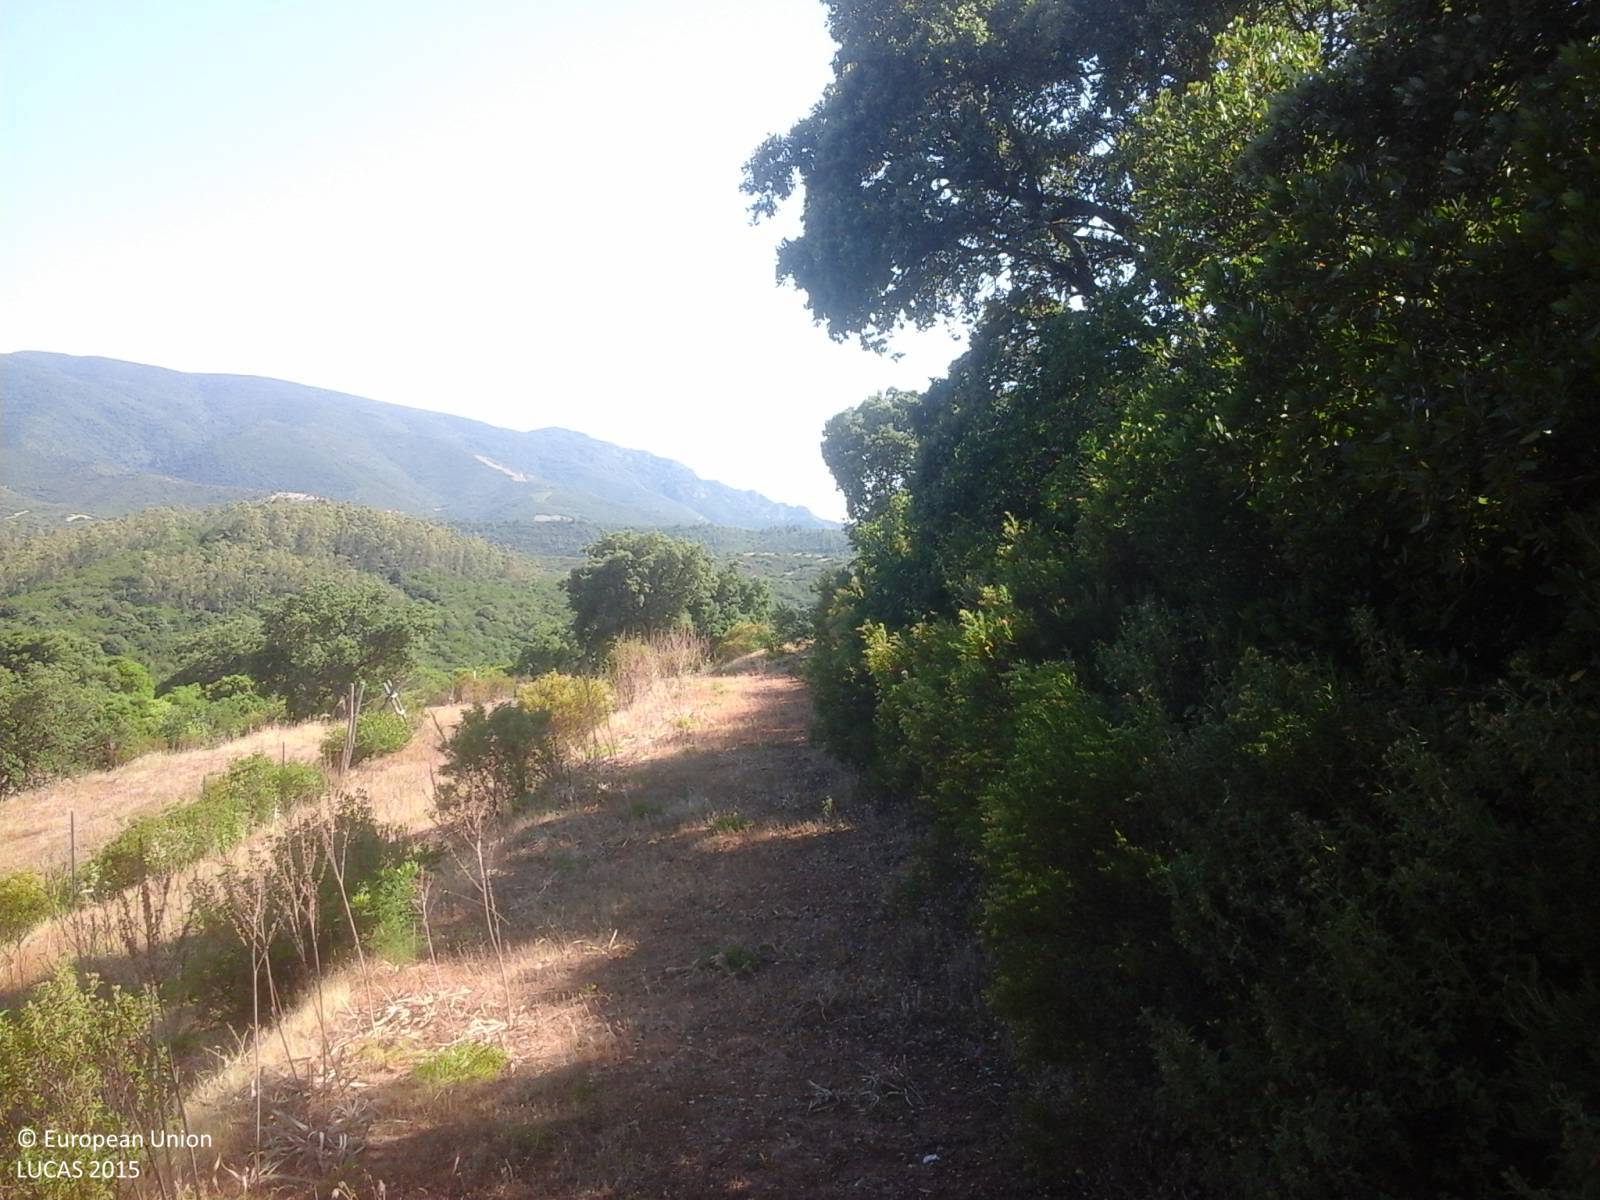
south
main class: Shrubland
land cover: Shrubland with sparse tree cover
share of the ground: > 75 %
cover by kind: shrubs 95 %, broadleaved forest trees 5 %
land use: Semi-natural and natural areas not in use
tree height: > 5 m
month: June
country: IT
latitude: 39.1909
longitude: 8.7688
